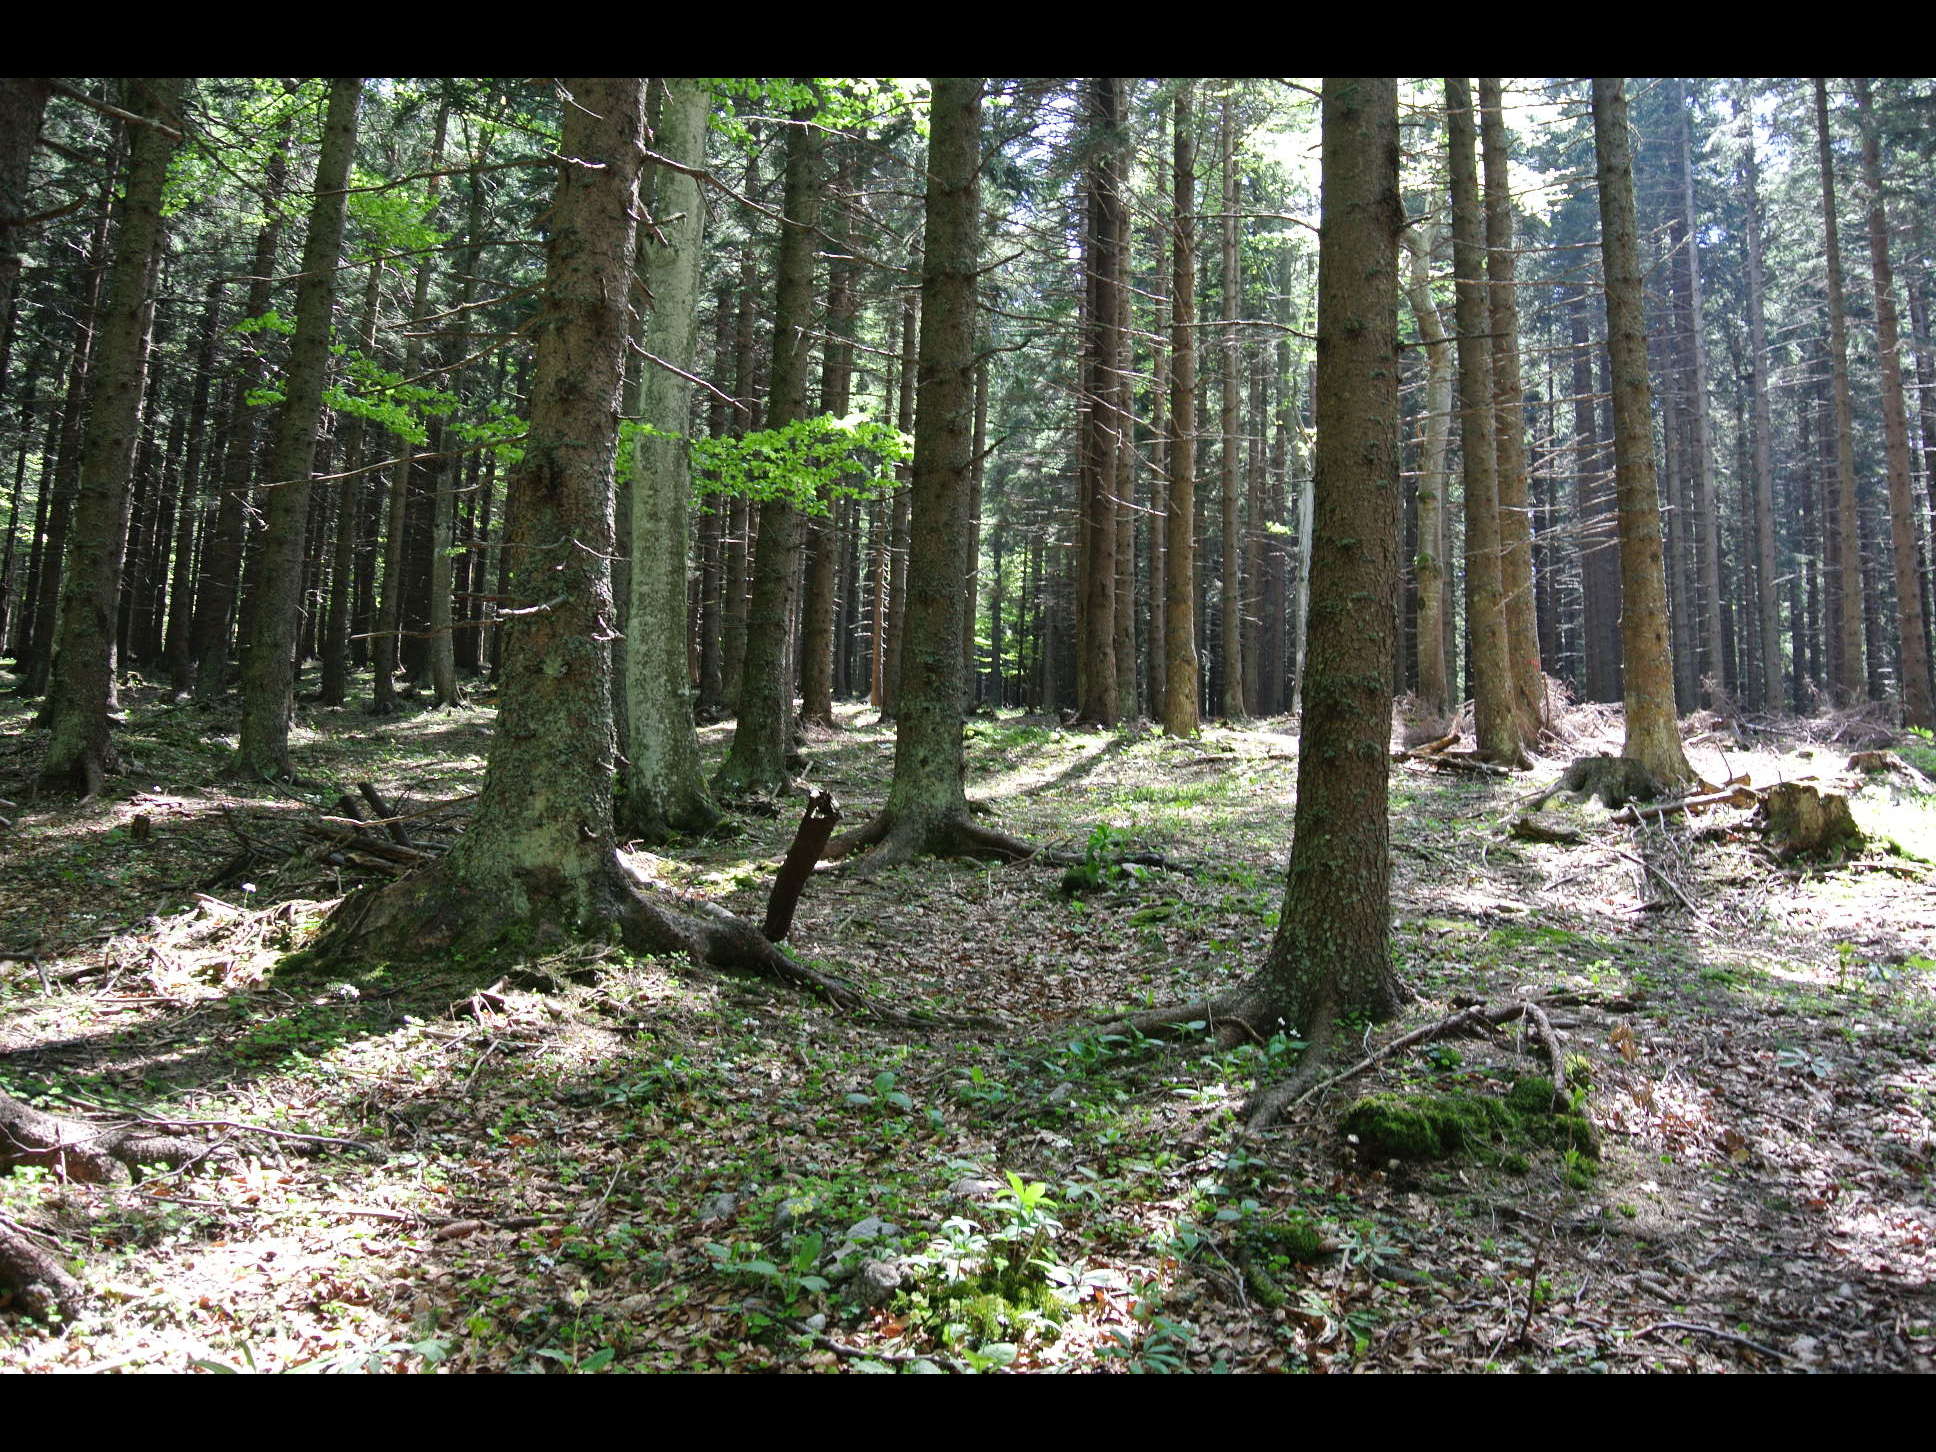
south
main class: Woodland
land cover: Spruce dominated mixed woodland
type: alpine coniferous forest
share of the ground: > 75 %
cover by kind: coniferous forest trees 70 %, broadleaved forest trees 30 %
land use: Forestry
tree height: > 5 m
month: May
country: AT
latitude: 47.7266
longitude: 15.8285
